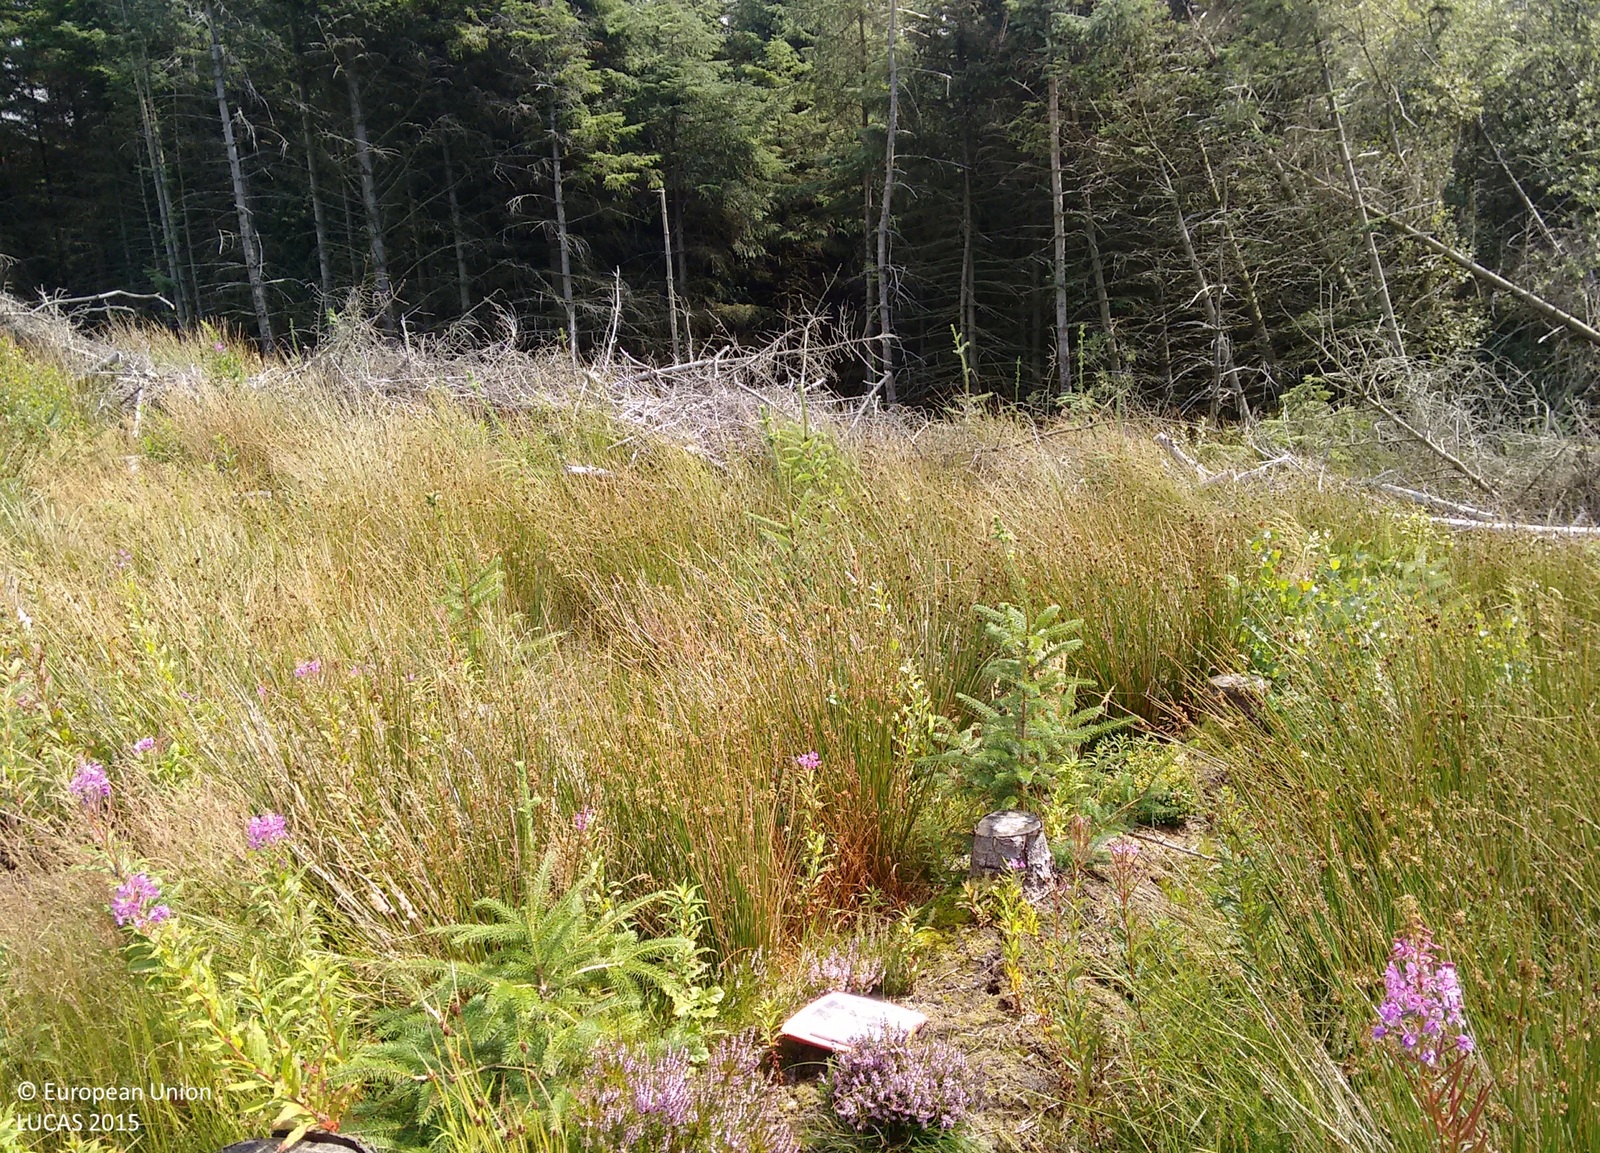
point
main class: Grassland
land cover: Grassland with sparse tree/shrub cover
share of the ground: > 75 %
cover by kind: herbaceous plants 95 %, coniferous forest trees 5 %
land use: Forestry
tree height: < 5 m
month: August
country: GB
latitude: 53.1548
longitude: -4.1085
